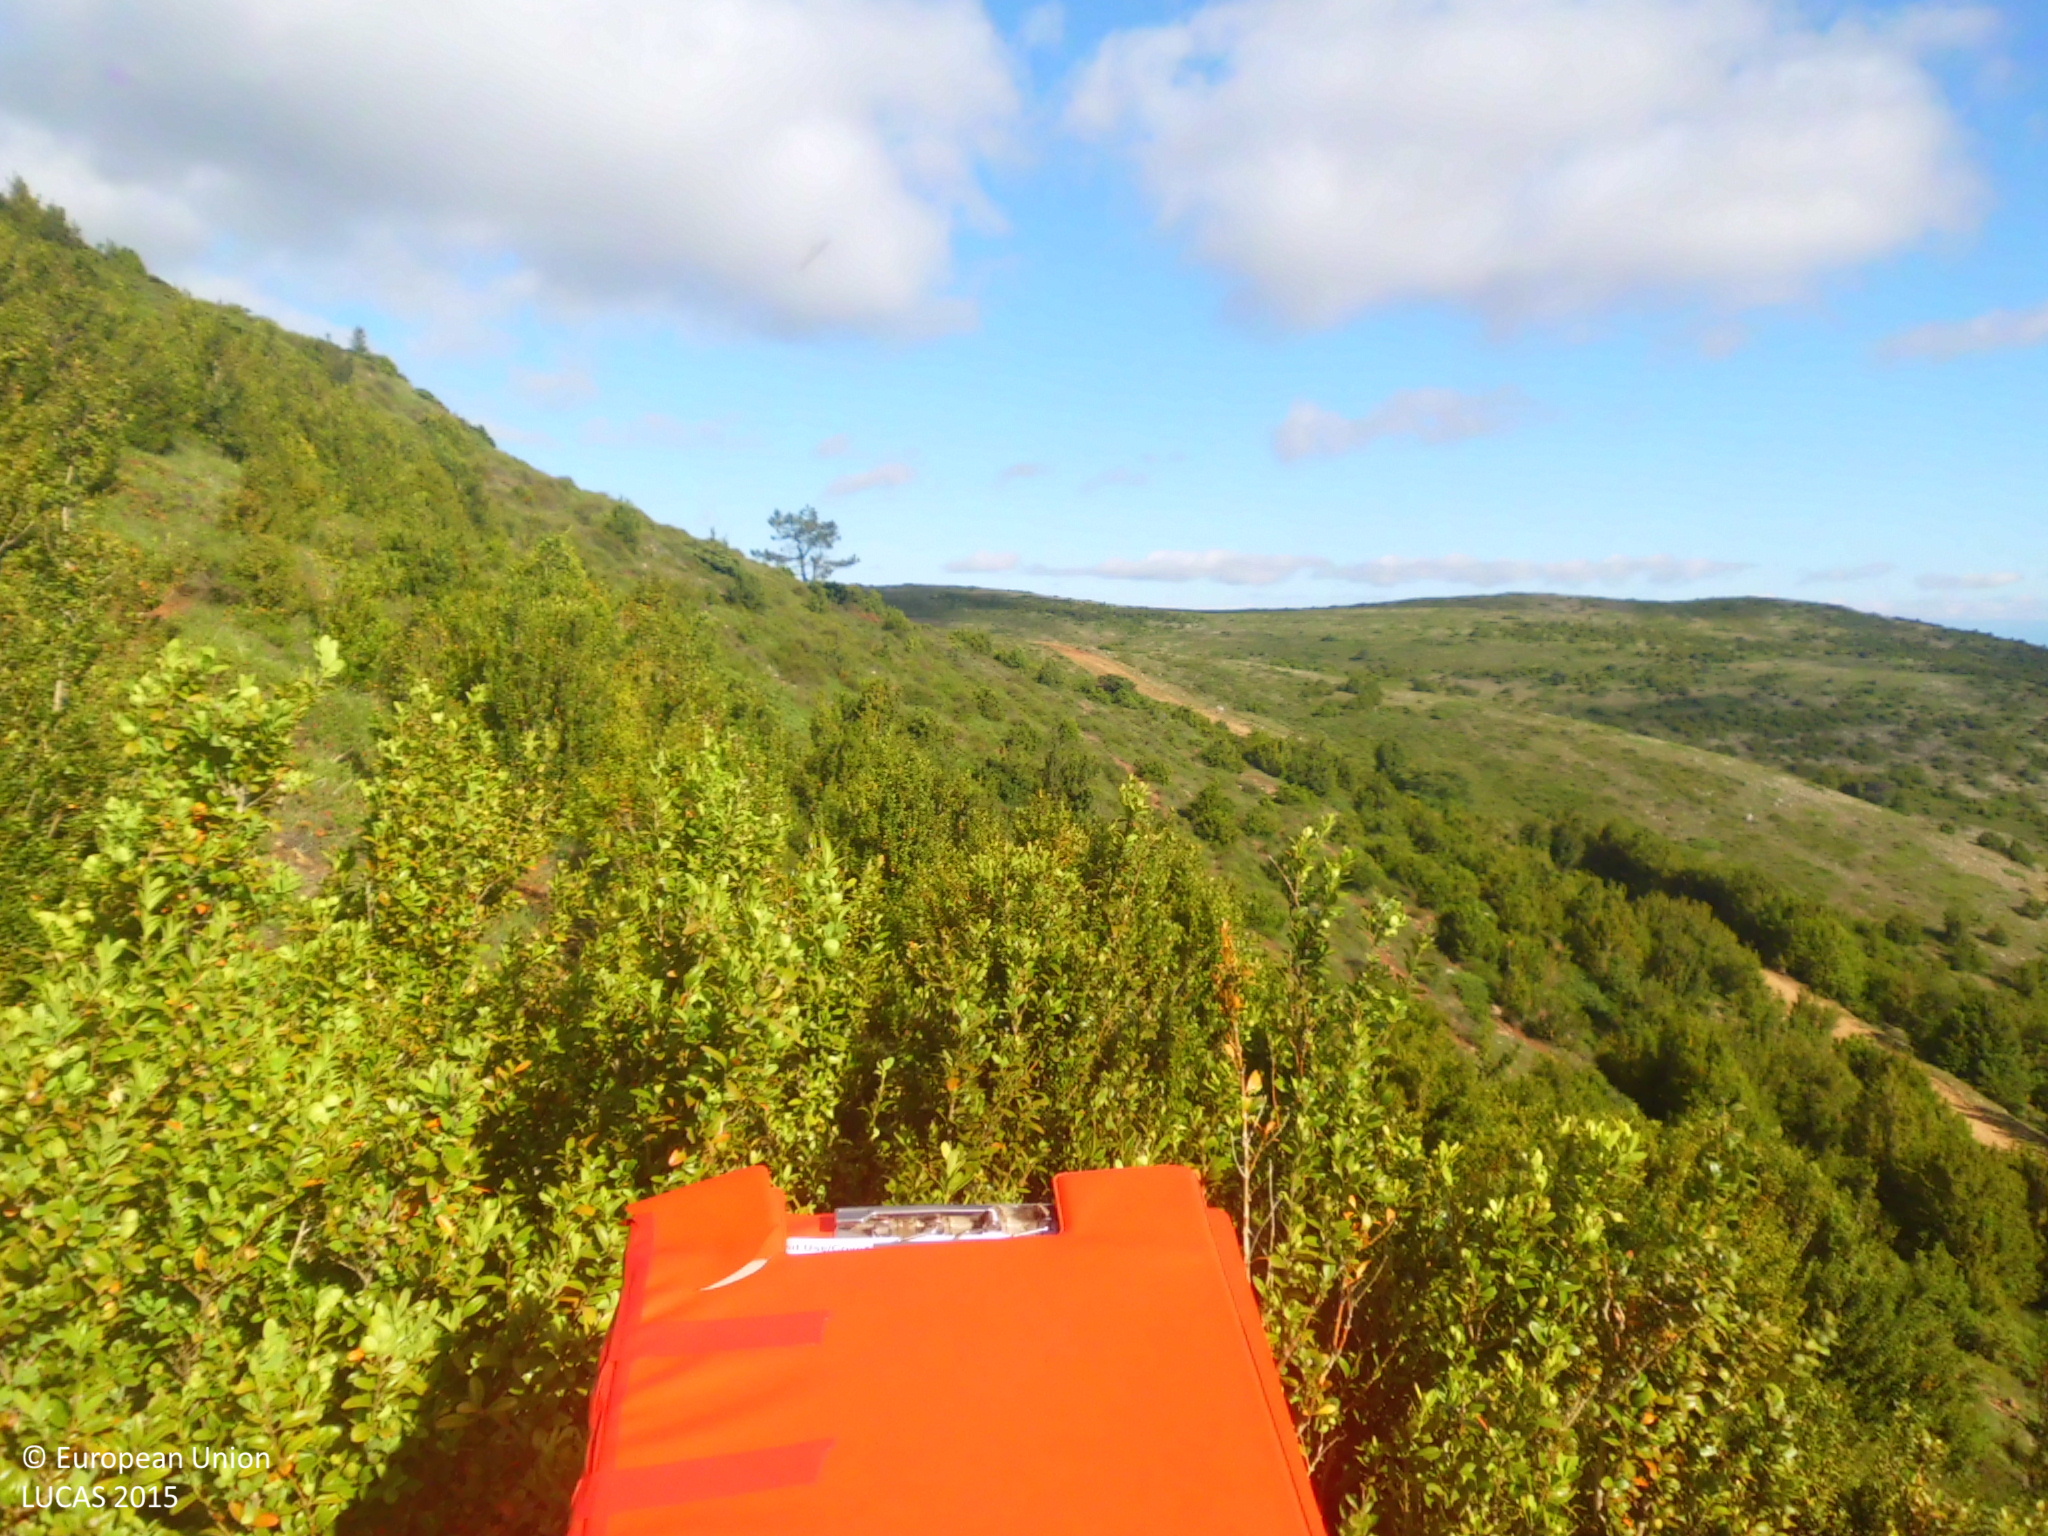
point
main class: Shrubland
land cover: Shrubland with sparse tree cover
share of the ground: > 75 %
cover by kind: shrubs 65 %, herbaceous plants 30 %, broadleaved forest trees 5 %
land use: Semi-natural and natural areas not in use
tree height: < 5 m
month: June
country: ES
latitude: 42.7122
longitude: -3.3807
